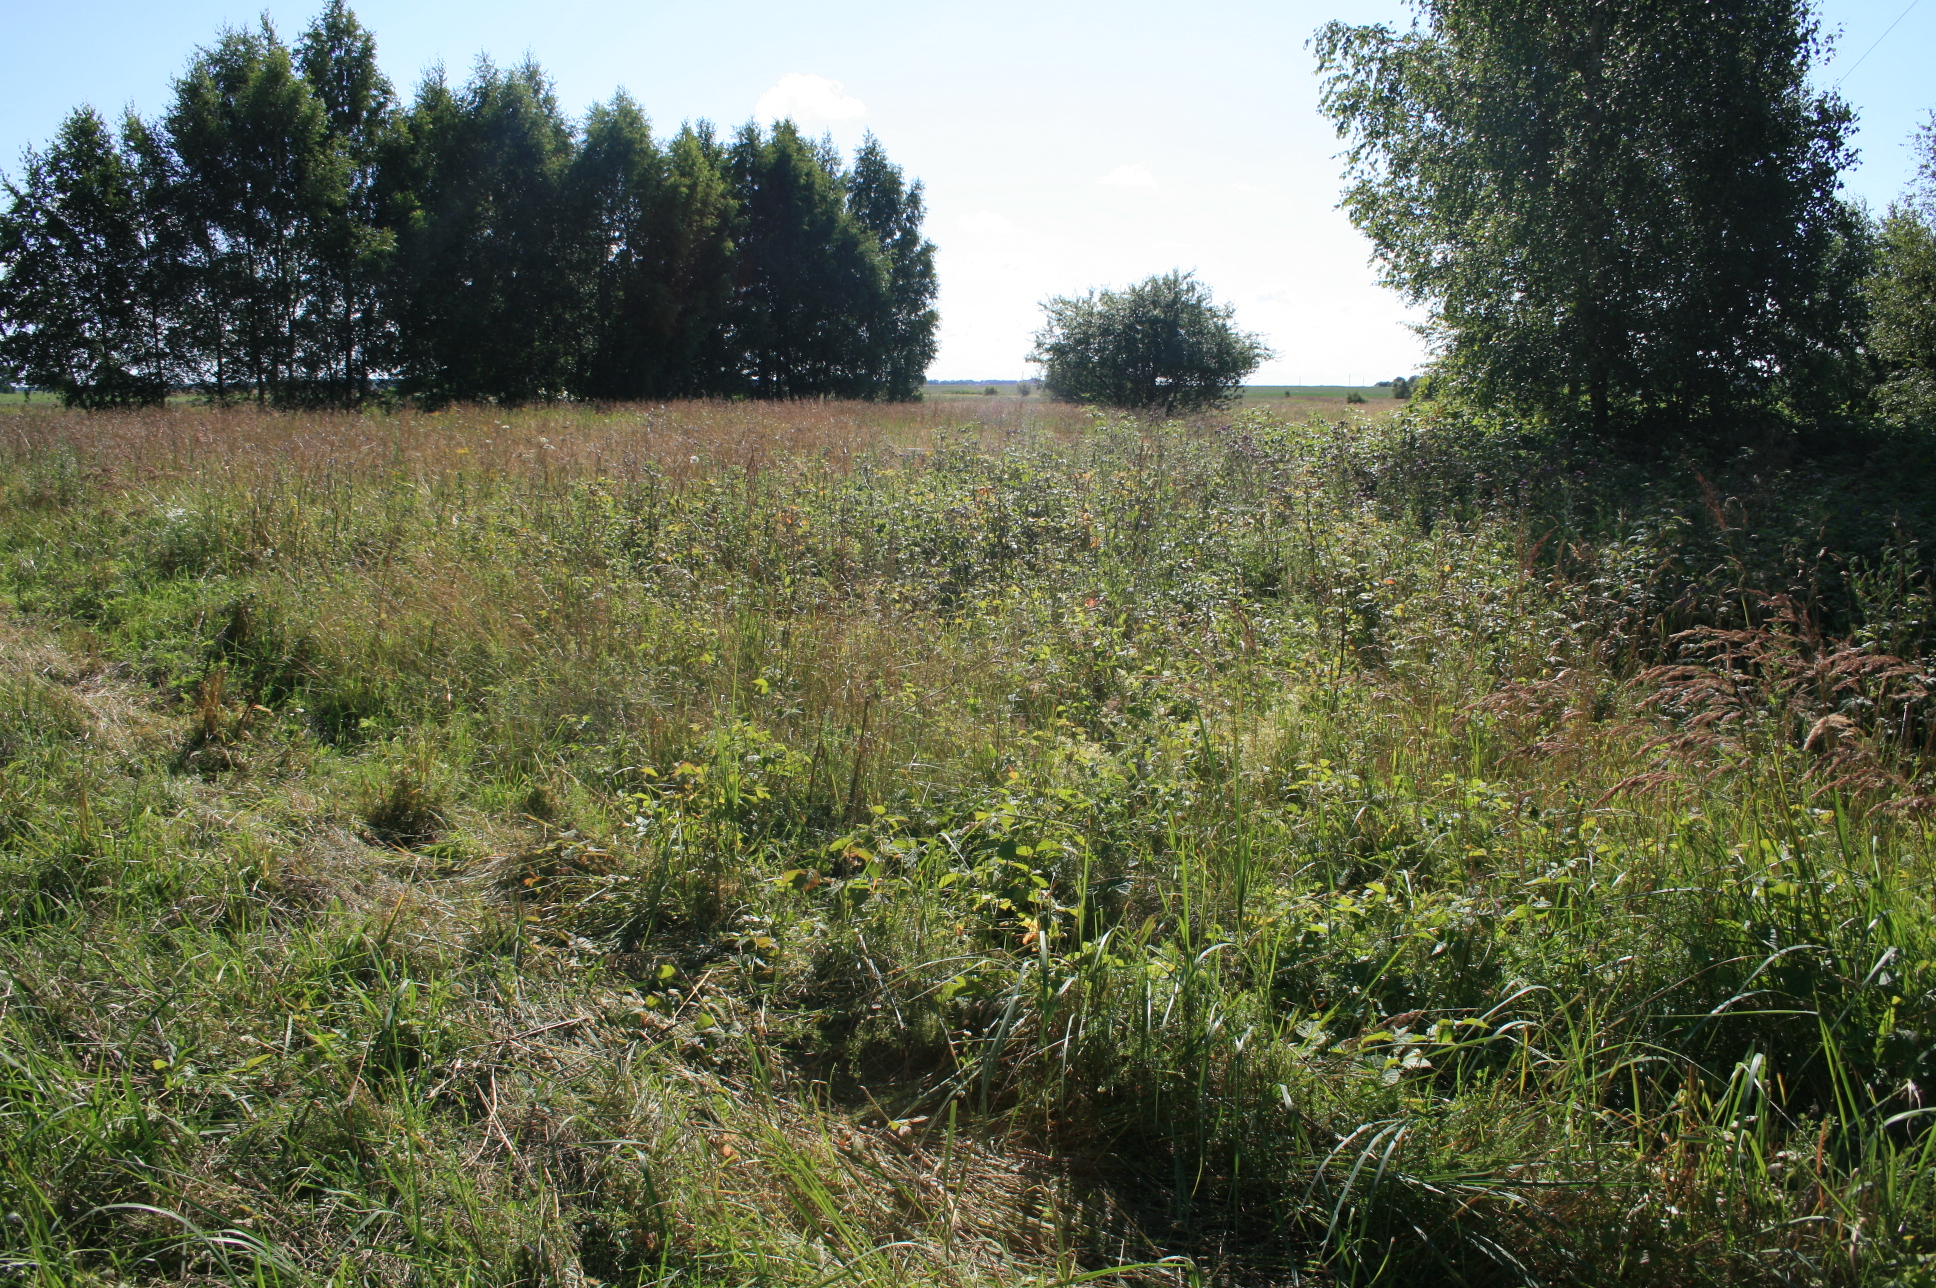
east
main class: Grassland
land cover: Spontaneously vegetated surfaces
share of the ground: > 75 %
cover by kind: herbaceous plants 100 %
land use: Agriculture (excluding fallow land and kitchen gardens)
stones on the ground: < 10 %
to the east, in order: Spontaneously vegetated surfaces; Broadleaved woodland; Spontaneously vegetated surfaces; Grassland without tree/shrub cover
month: July
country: LT
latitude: 55.3839
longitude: 21.2336
